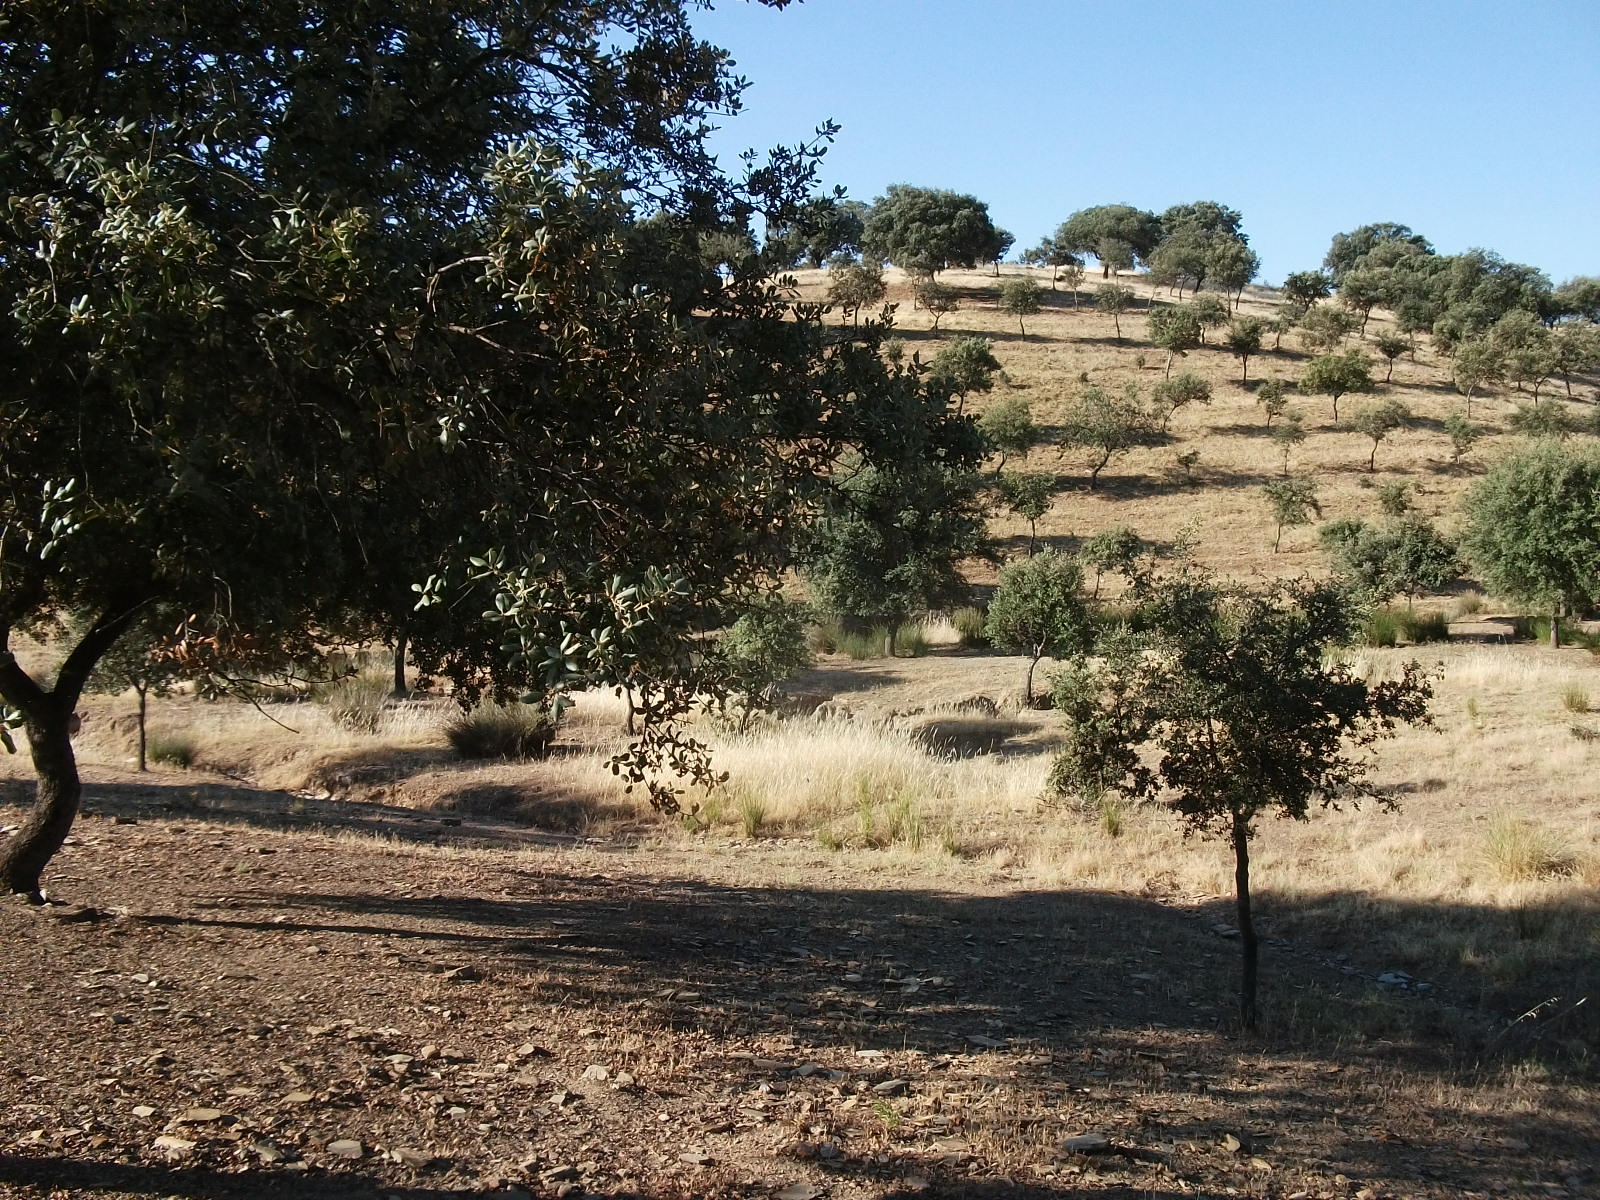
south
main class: Woodland
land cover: Broadleaved woodland
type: broadleaved evergreen forest
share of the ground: 50 - 75 %
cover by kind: broadleaved forest trees 70 %, herbaceous plants 20 %, unconsolidated bare surface 10 %
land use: Agriculture (excluding fallow land and kitchen gardens)
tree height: < 5 m
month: June
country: ES
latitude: 37.6609
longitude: -7.0176
